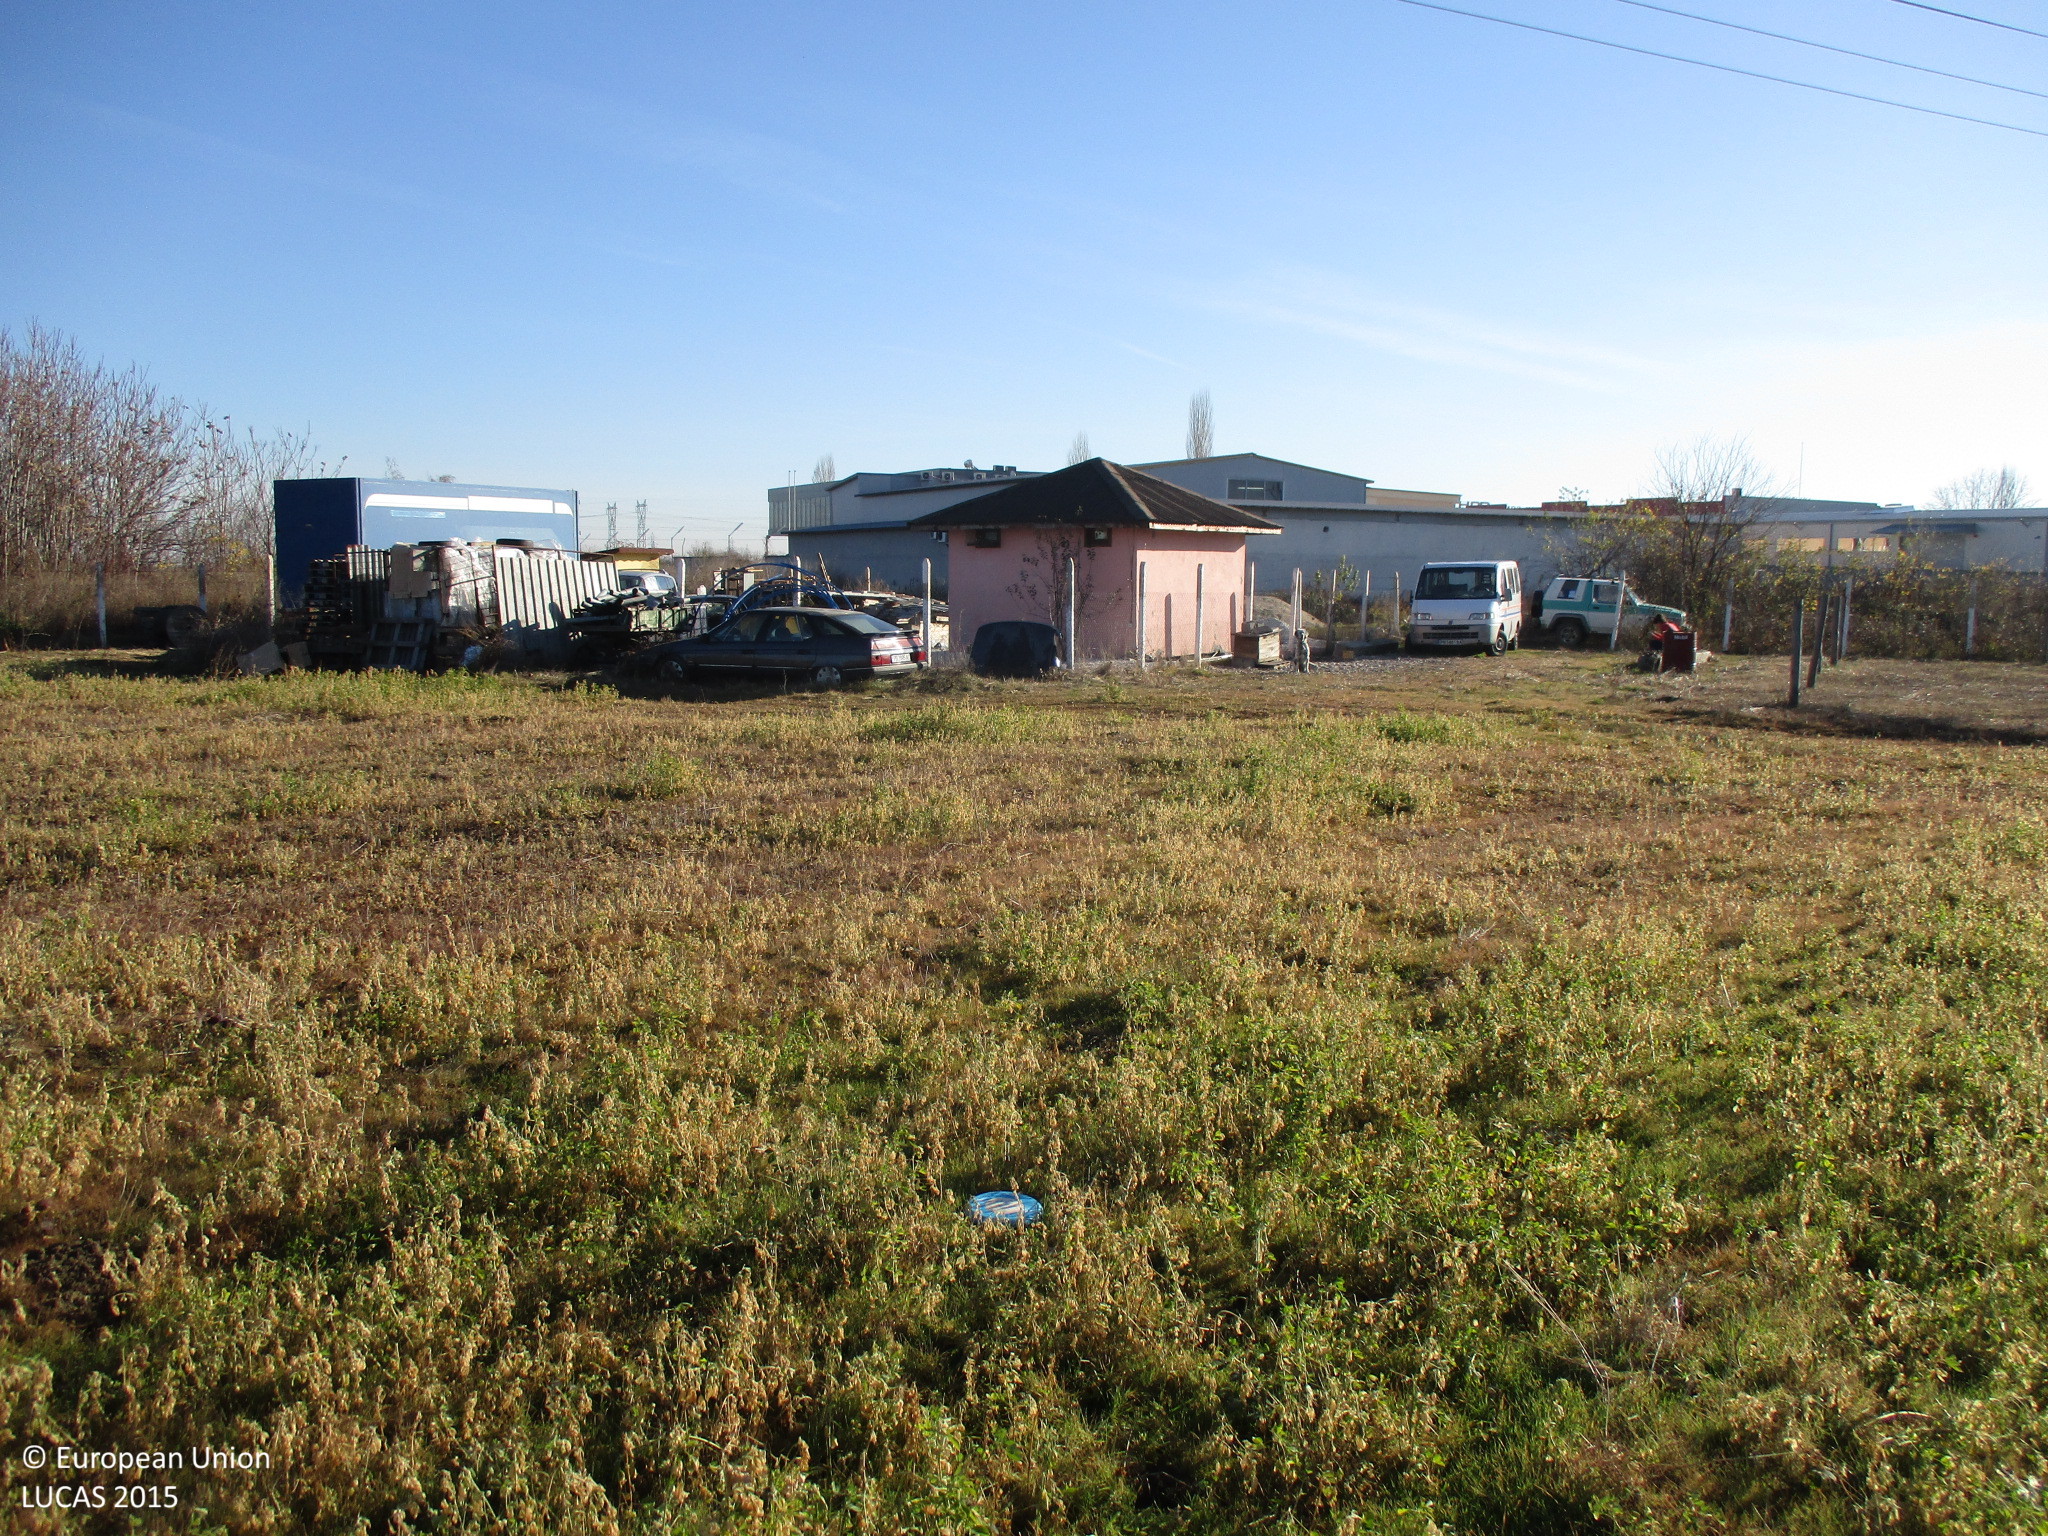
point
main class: Cropland
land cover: Lucerne
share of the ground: 50 - 75 %
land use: Agriculture (excluding fallow land and kitchen gardens)
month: December
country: BG
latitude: 42.0930
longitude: 24.7898
